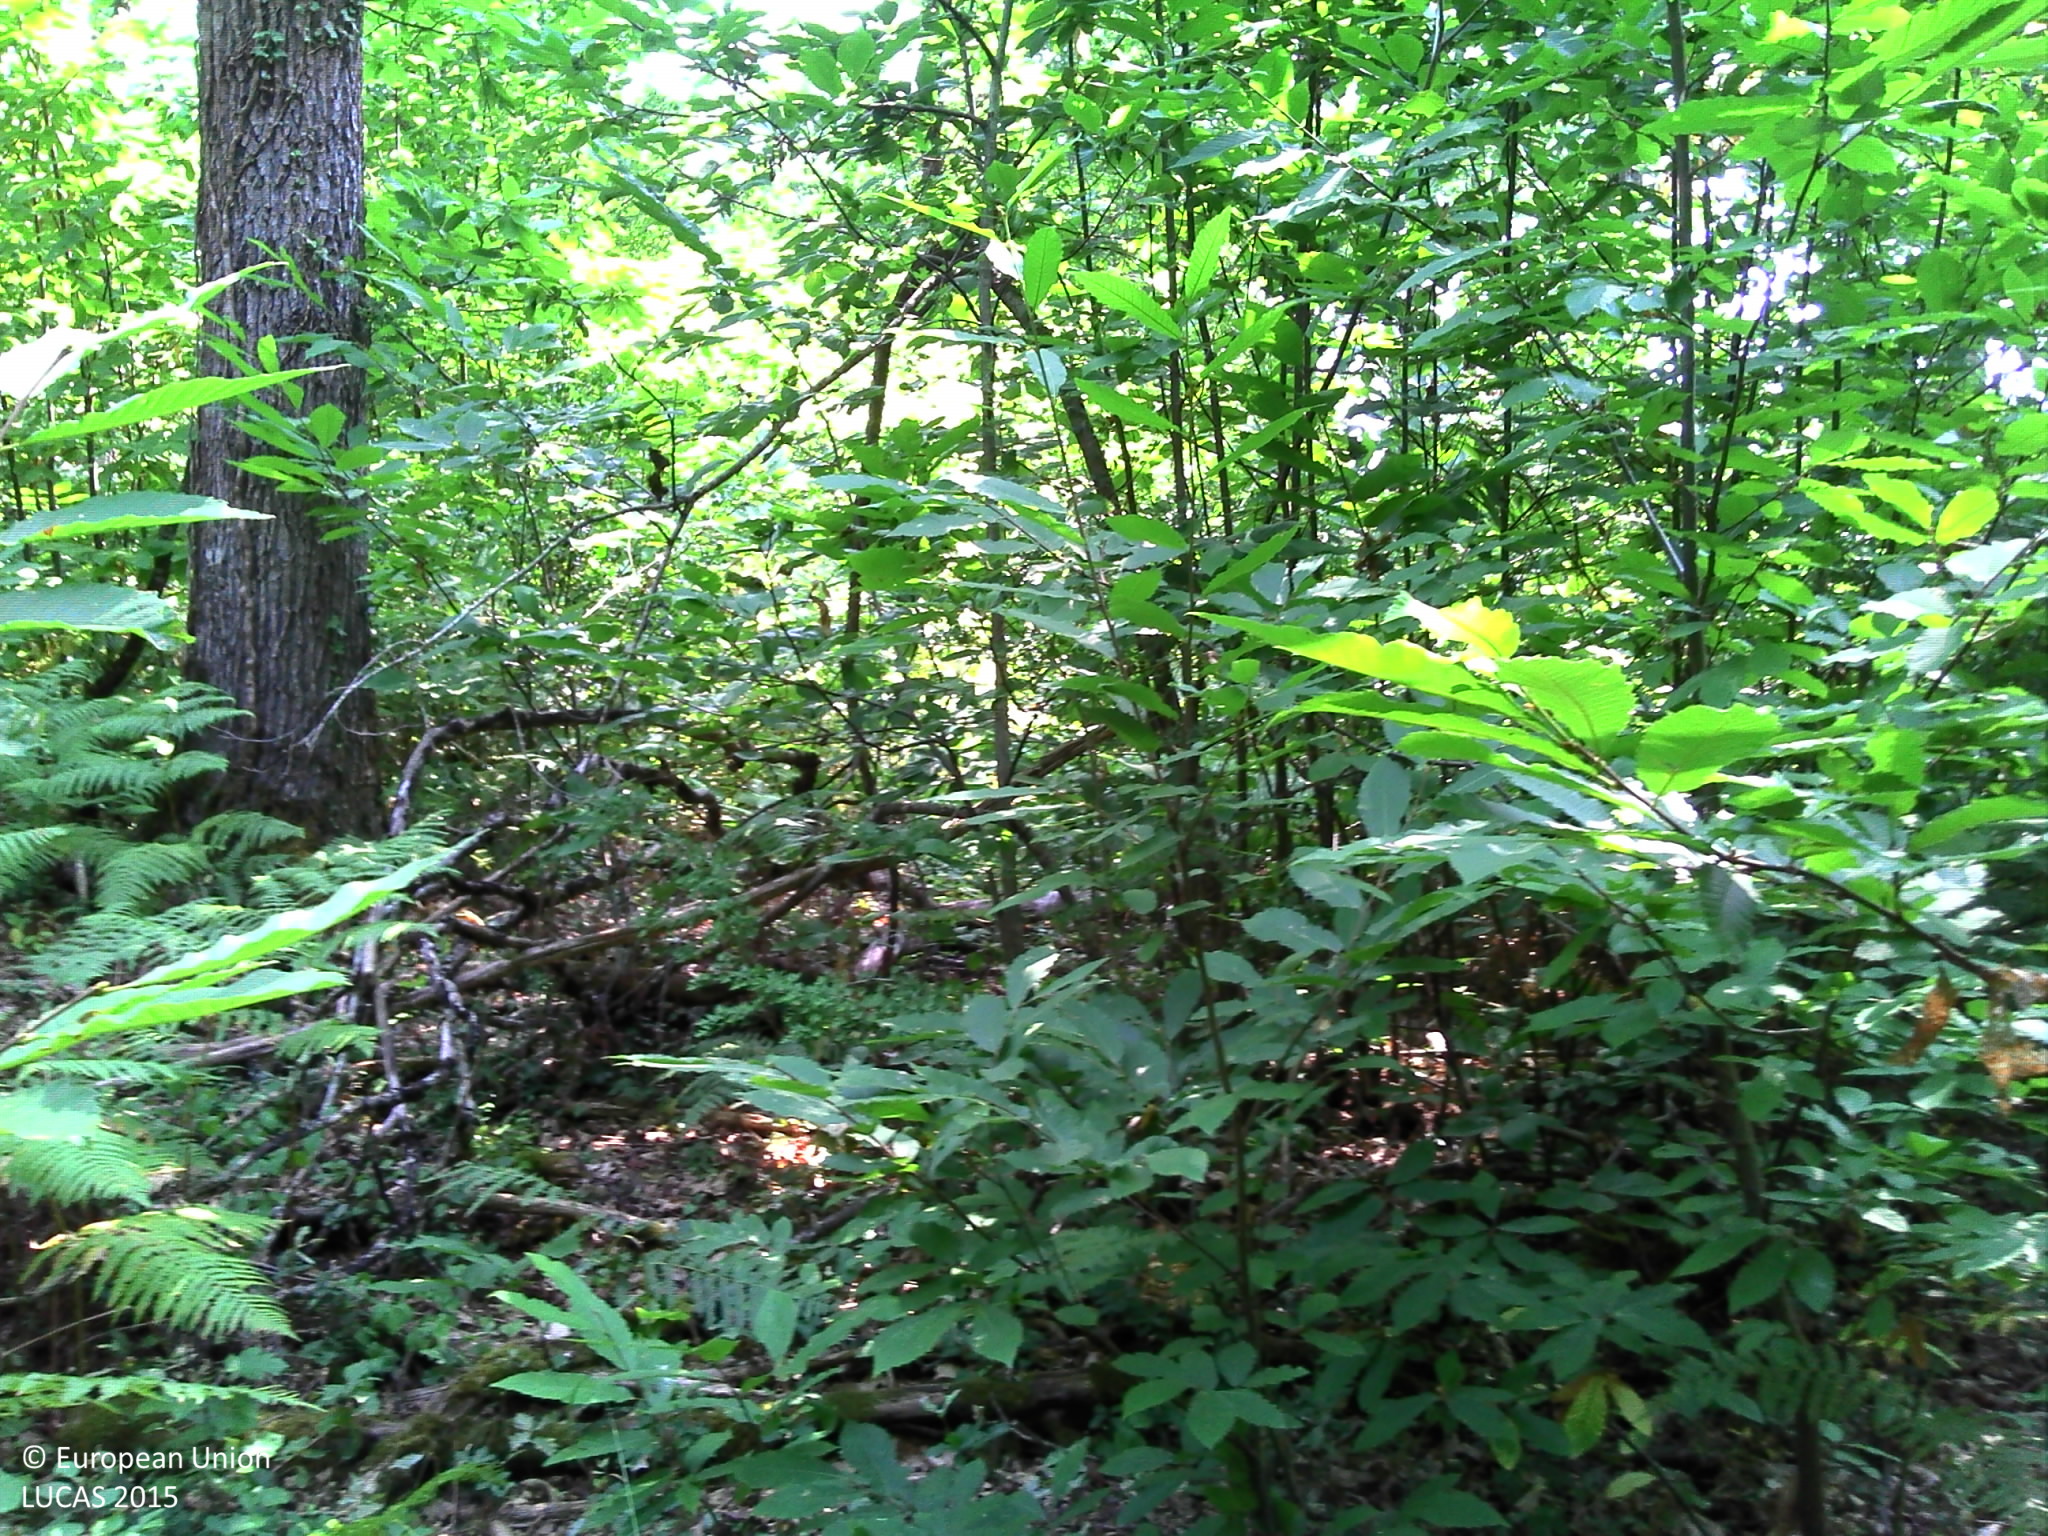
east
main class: Woodland
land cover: Broadleaved woodland
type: thermophilous deciduous forest
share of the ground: > 75 %
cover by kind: broadleaved forest trees 70 %, shrubs 15 %, herbaceous plants 15 %
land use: Forestry
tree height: > 5 m
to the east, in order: Broadleaved woodland; Shruby margins; Fences; Electric lines; Ditches and canals; Grass margins; Paved roads, cycling and walking lanes; Grassland without tree/shrub cover; Artificial constructions in urban areas
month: July
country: FR
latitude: 45.1469
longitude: 0.6930
